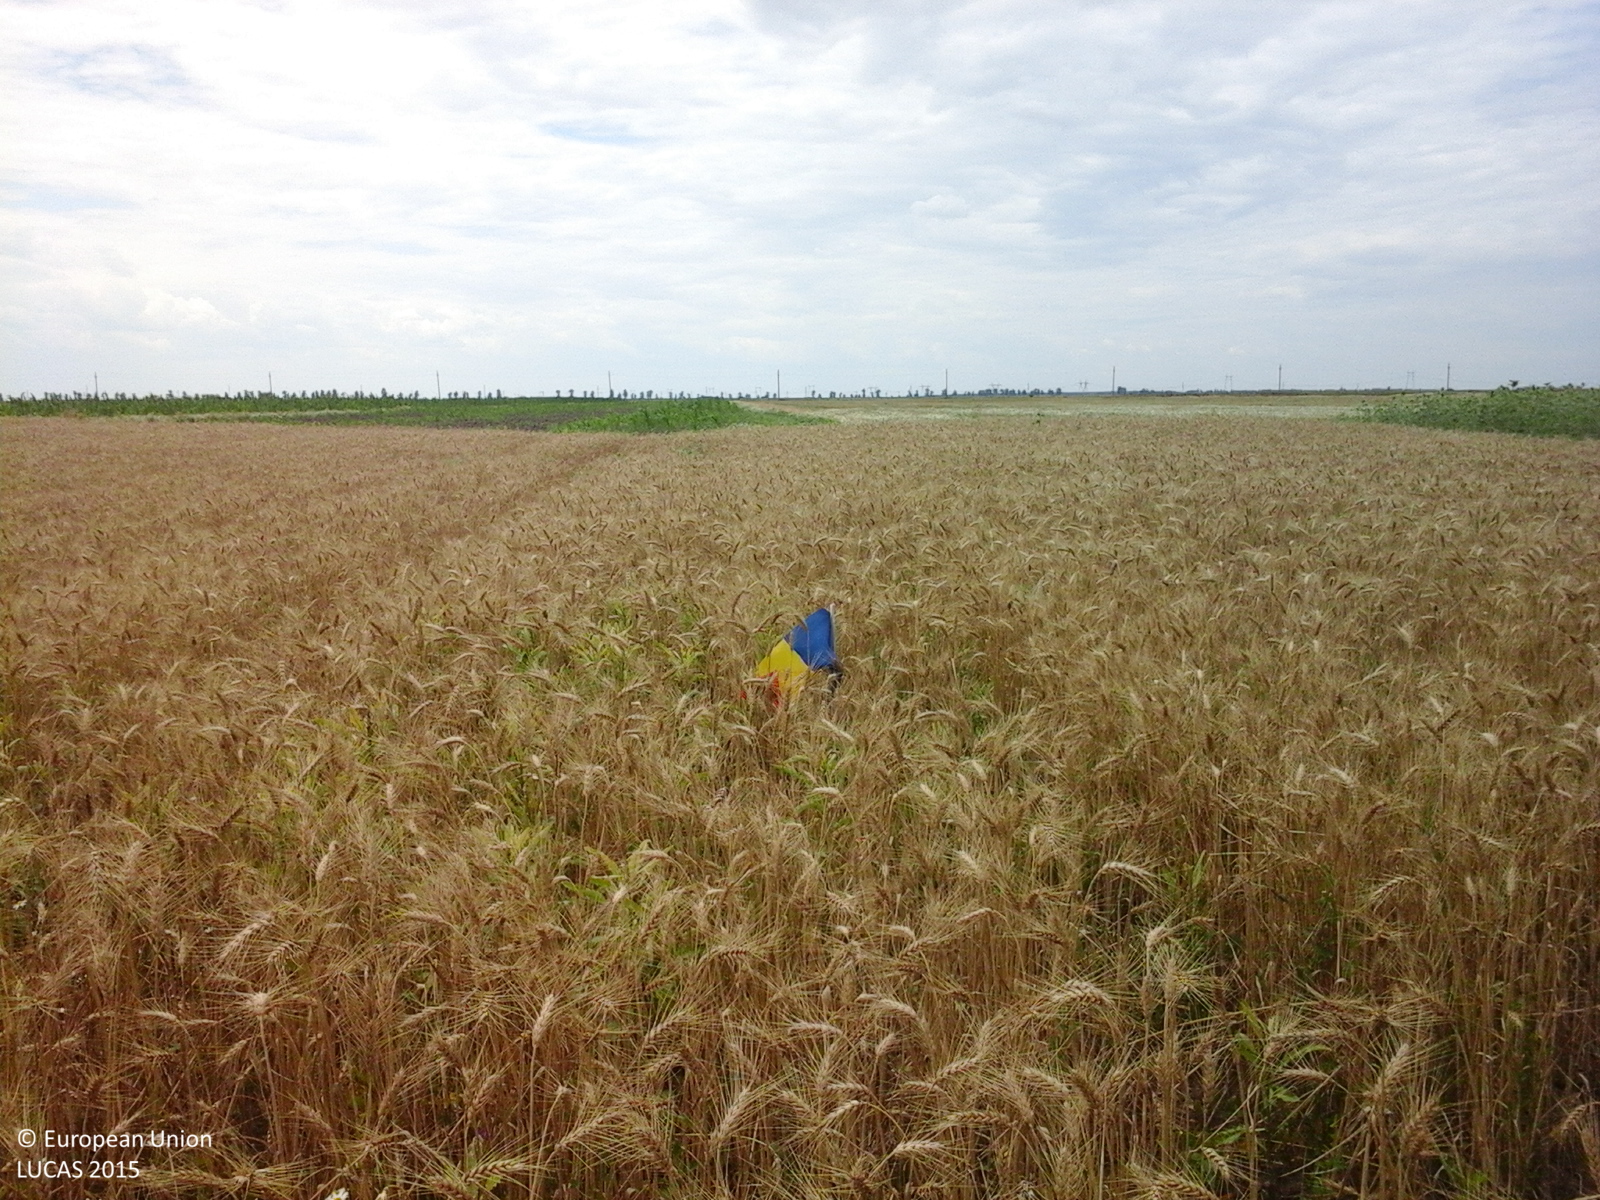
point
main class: Cropland
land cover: Common wheat
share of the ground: > 75 %
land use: Agriculture (excluding fallow land and kitchen gardens)
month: July
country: RO
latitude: 44.2331
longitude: 25.5525
